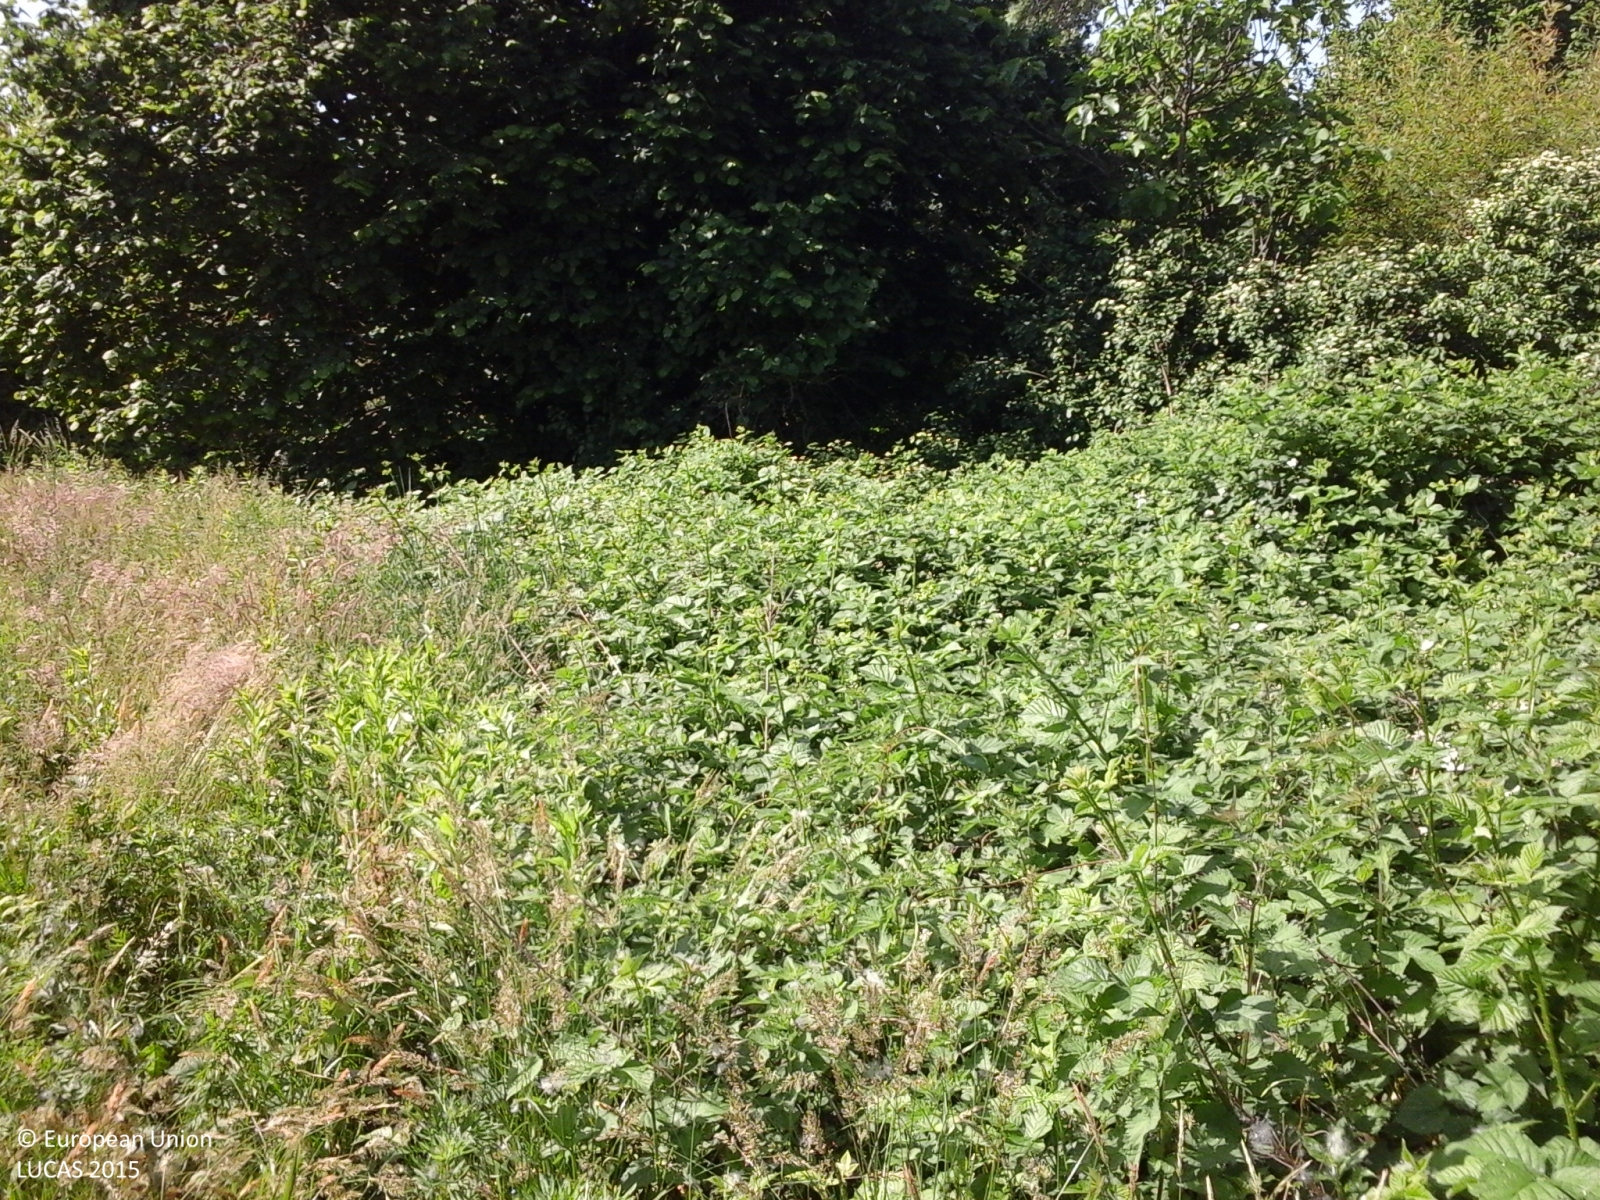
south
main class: Shrubland
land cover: Shrubland with sparse tree cover
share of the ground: > 75 %
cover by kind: shrubs 80 %, herbaceous plants 15 %, broadleaved forest trees 5 %
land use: Fallow land
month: May
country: IT
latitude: 45.5726
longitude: 9.0917
